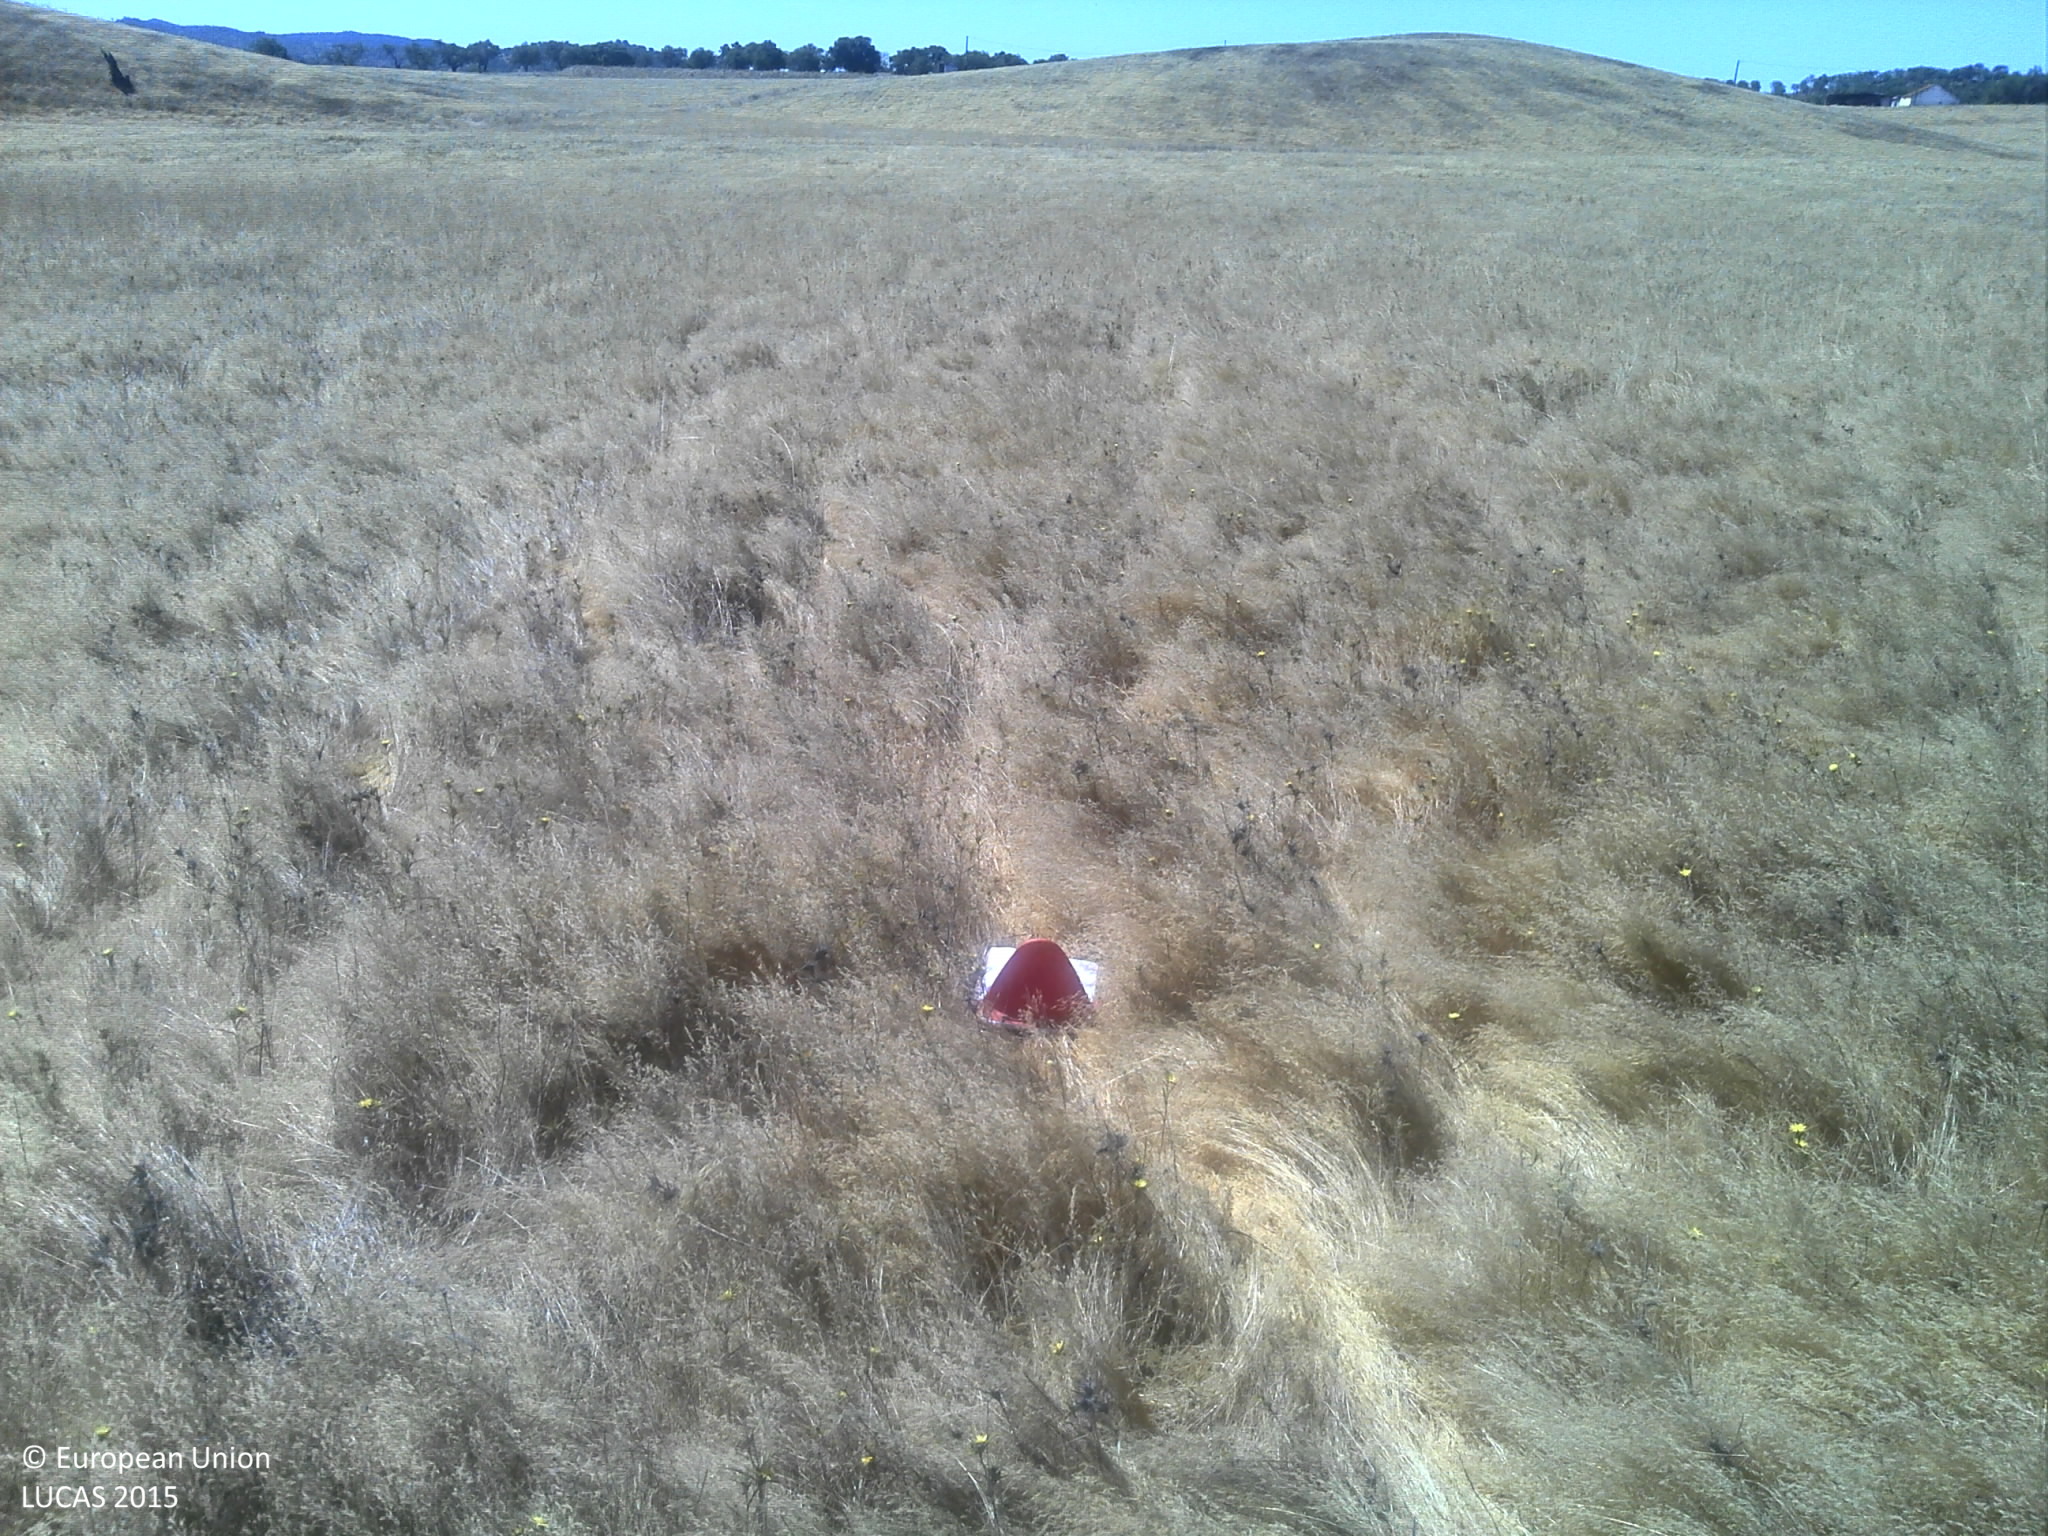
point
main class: Grassland
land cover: Grassland without tree/shrub cover
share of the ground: > 75 %
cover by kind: herbaceous plants 75 %, consolidated bare surface 25 %
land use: Agriculture (excluding fallow land and kitchen gardens)
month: August
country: PT
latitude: 37.7493
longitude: -8.5033
